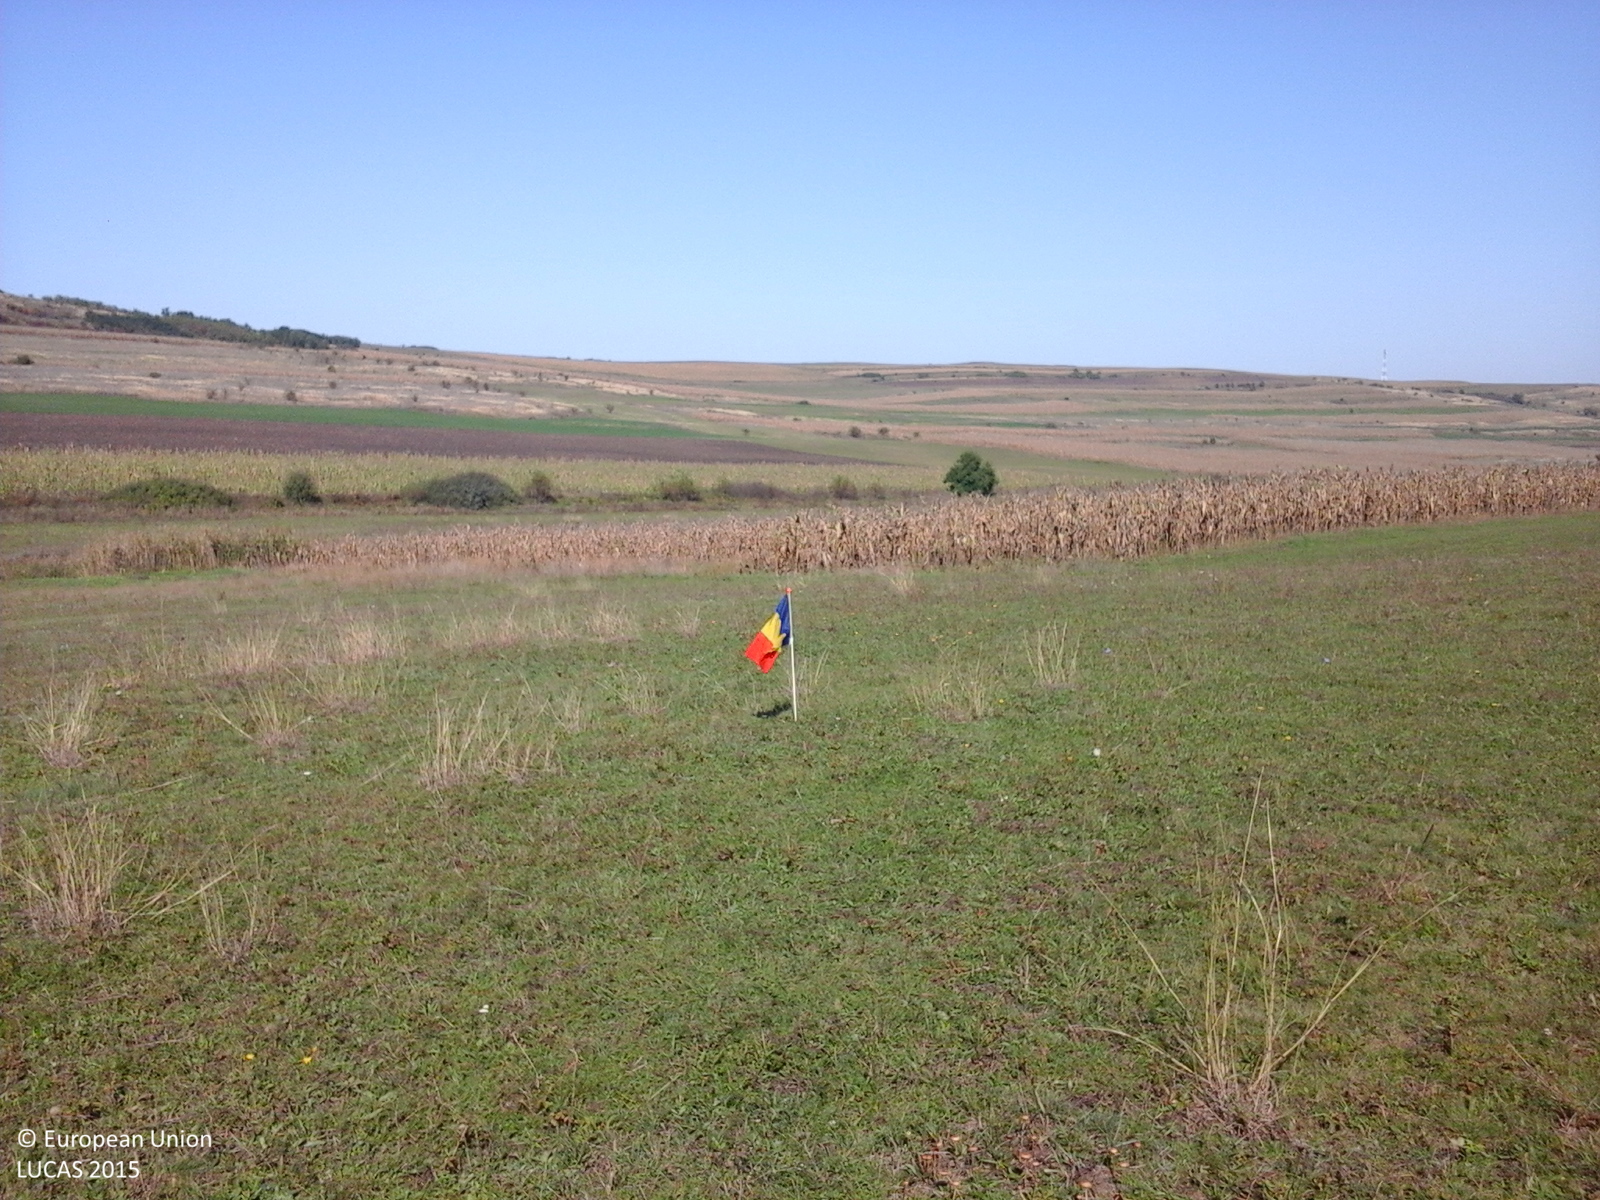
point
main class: Grassland
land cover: Grassland without tree/shrub cover
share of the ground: > 75 %
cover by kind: herbaceous plants 100 %
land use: Agriculture (excluding fallow land and kitchen gardens)
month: October
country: RO
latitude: 46.0749
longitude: 23.9204
